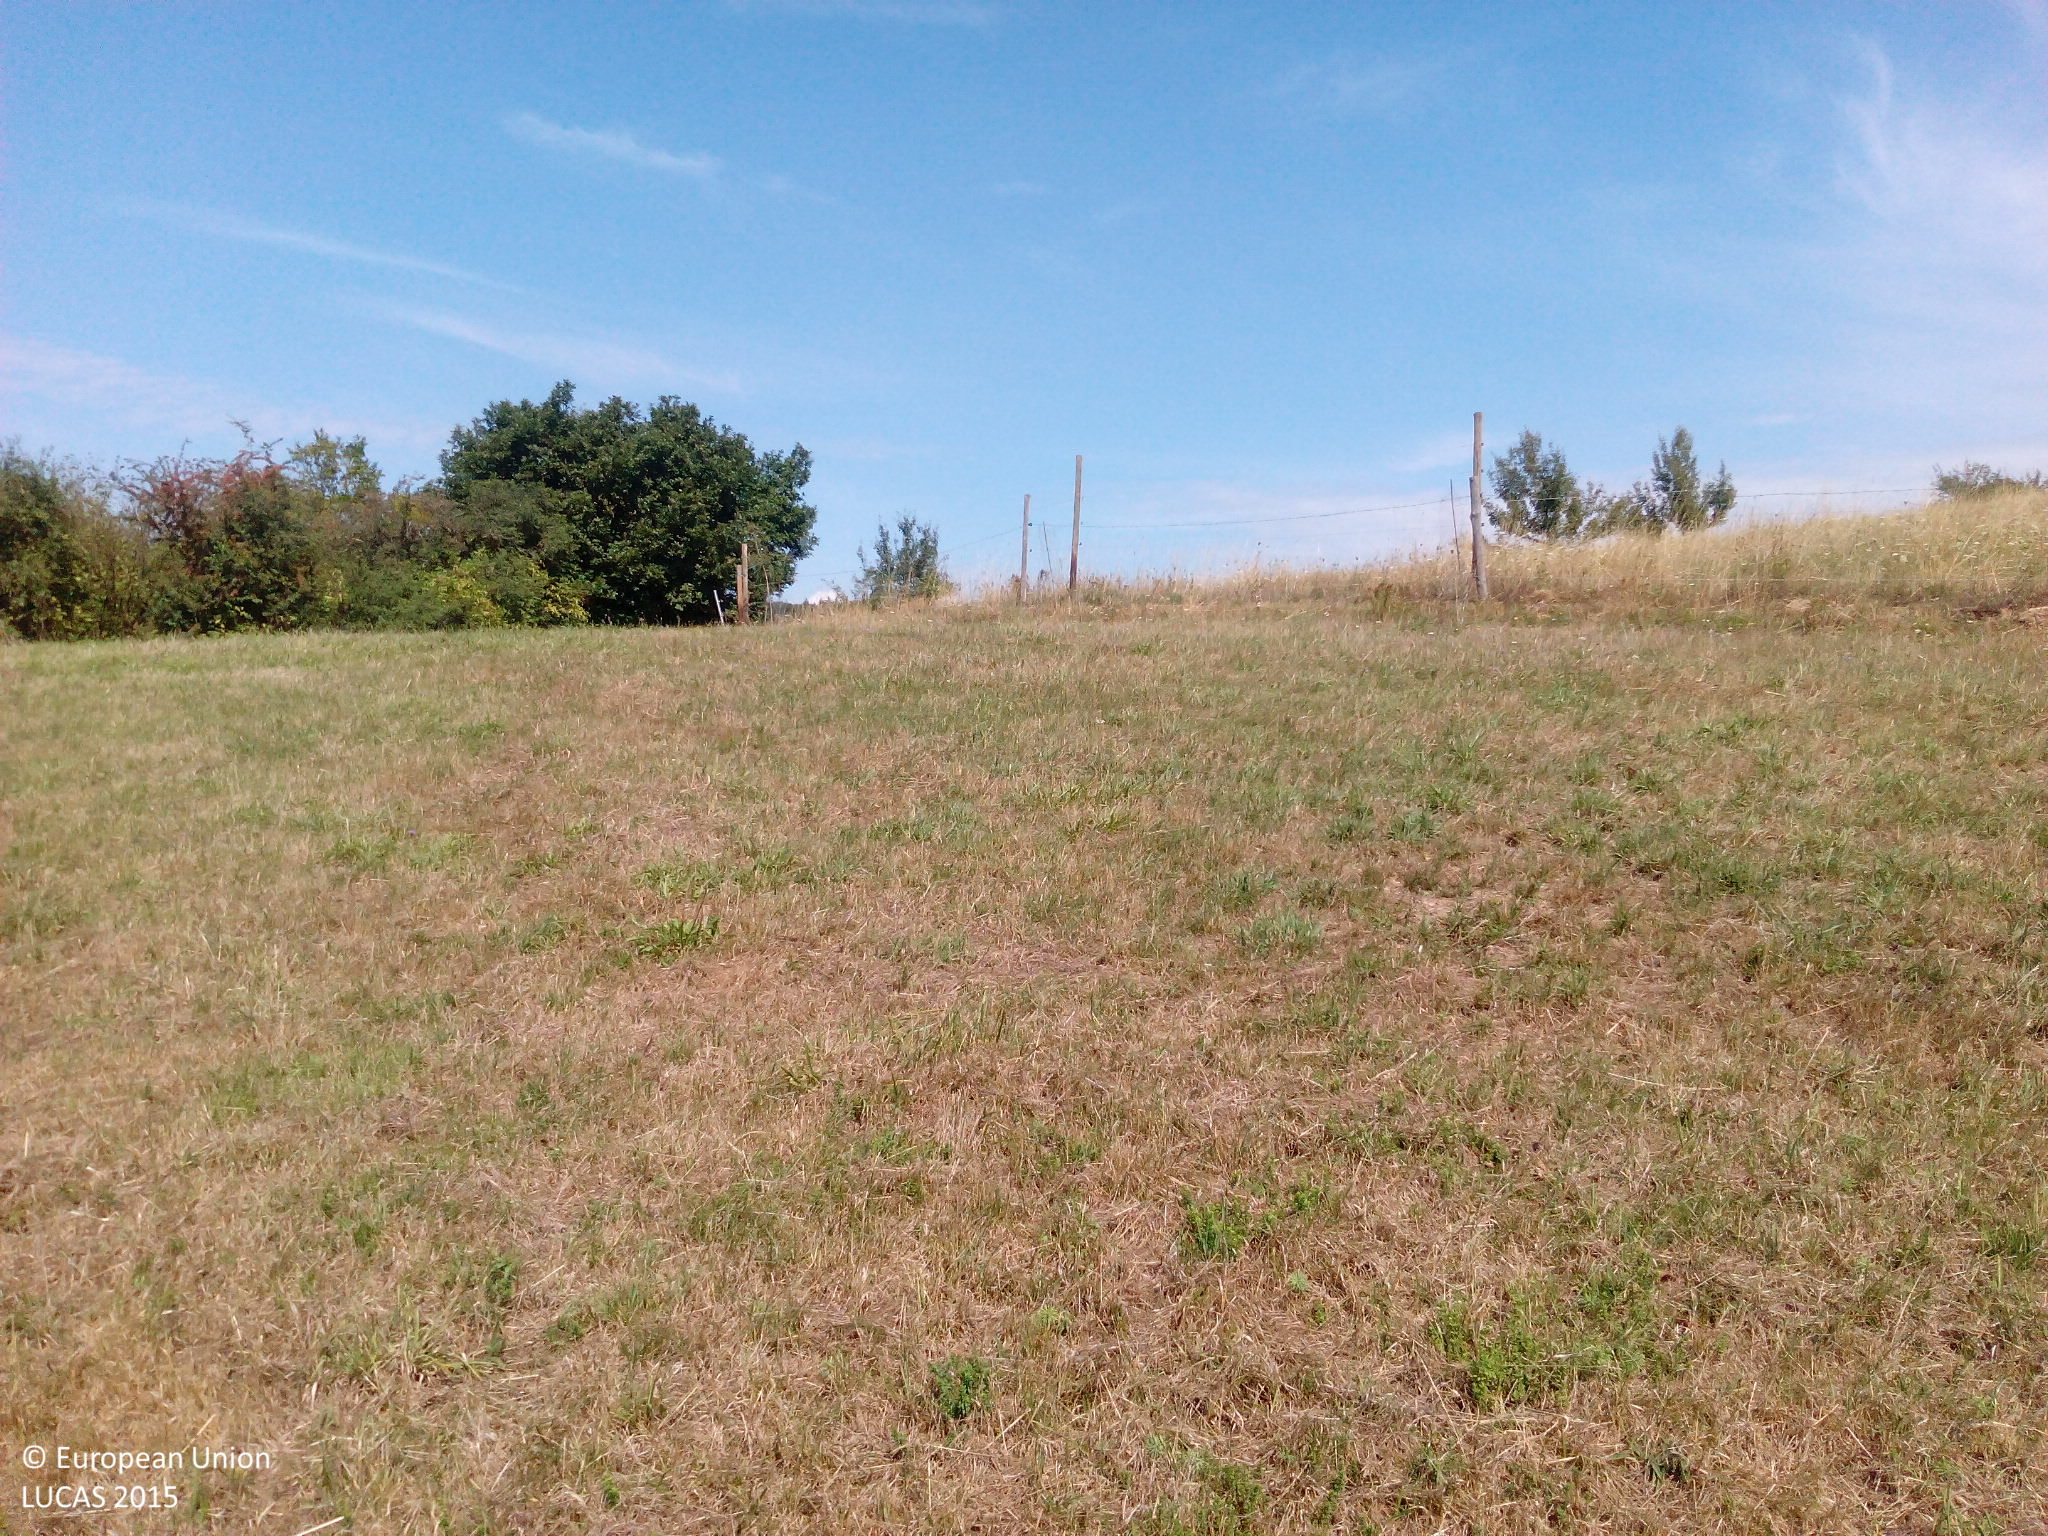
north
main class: Grassland
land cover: Grassland without tree/shrub cover
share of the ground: > 75 %
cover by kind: herbaceous plants 90 %, unconsolidated bare surface 10 %
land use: Agriculture (excluding fallow land and kitchen gardens)
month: August
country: DE
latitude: 50.2280
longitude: 7.4631
